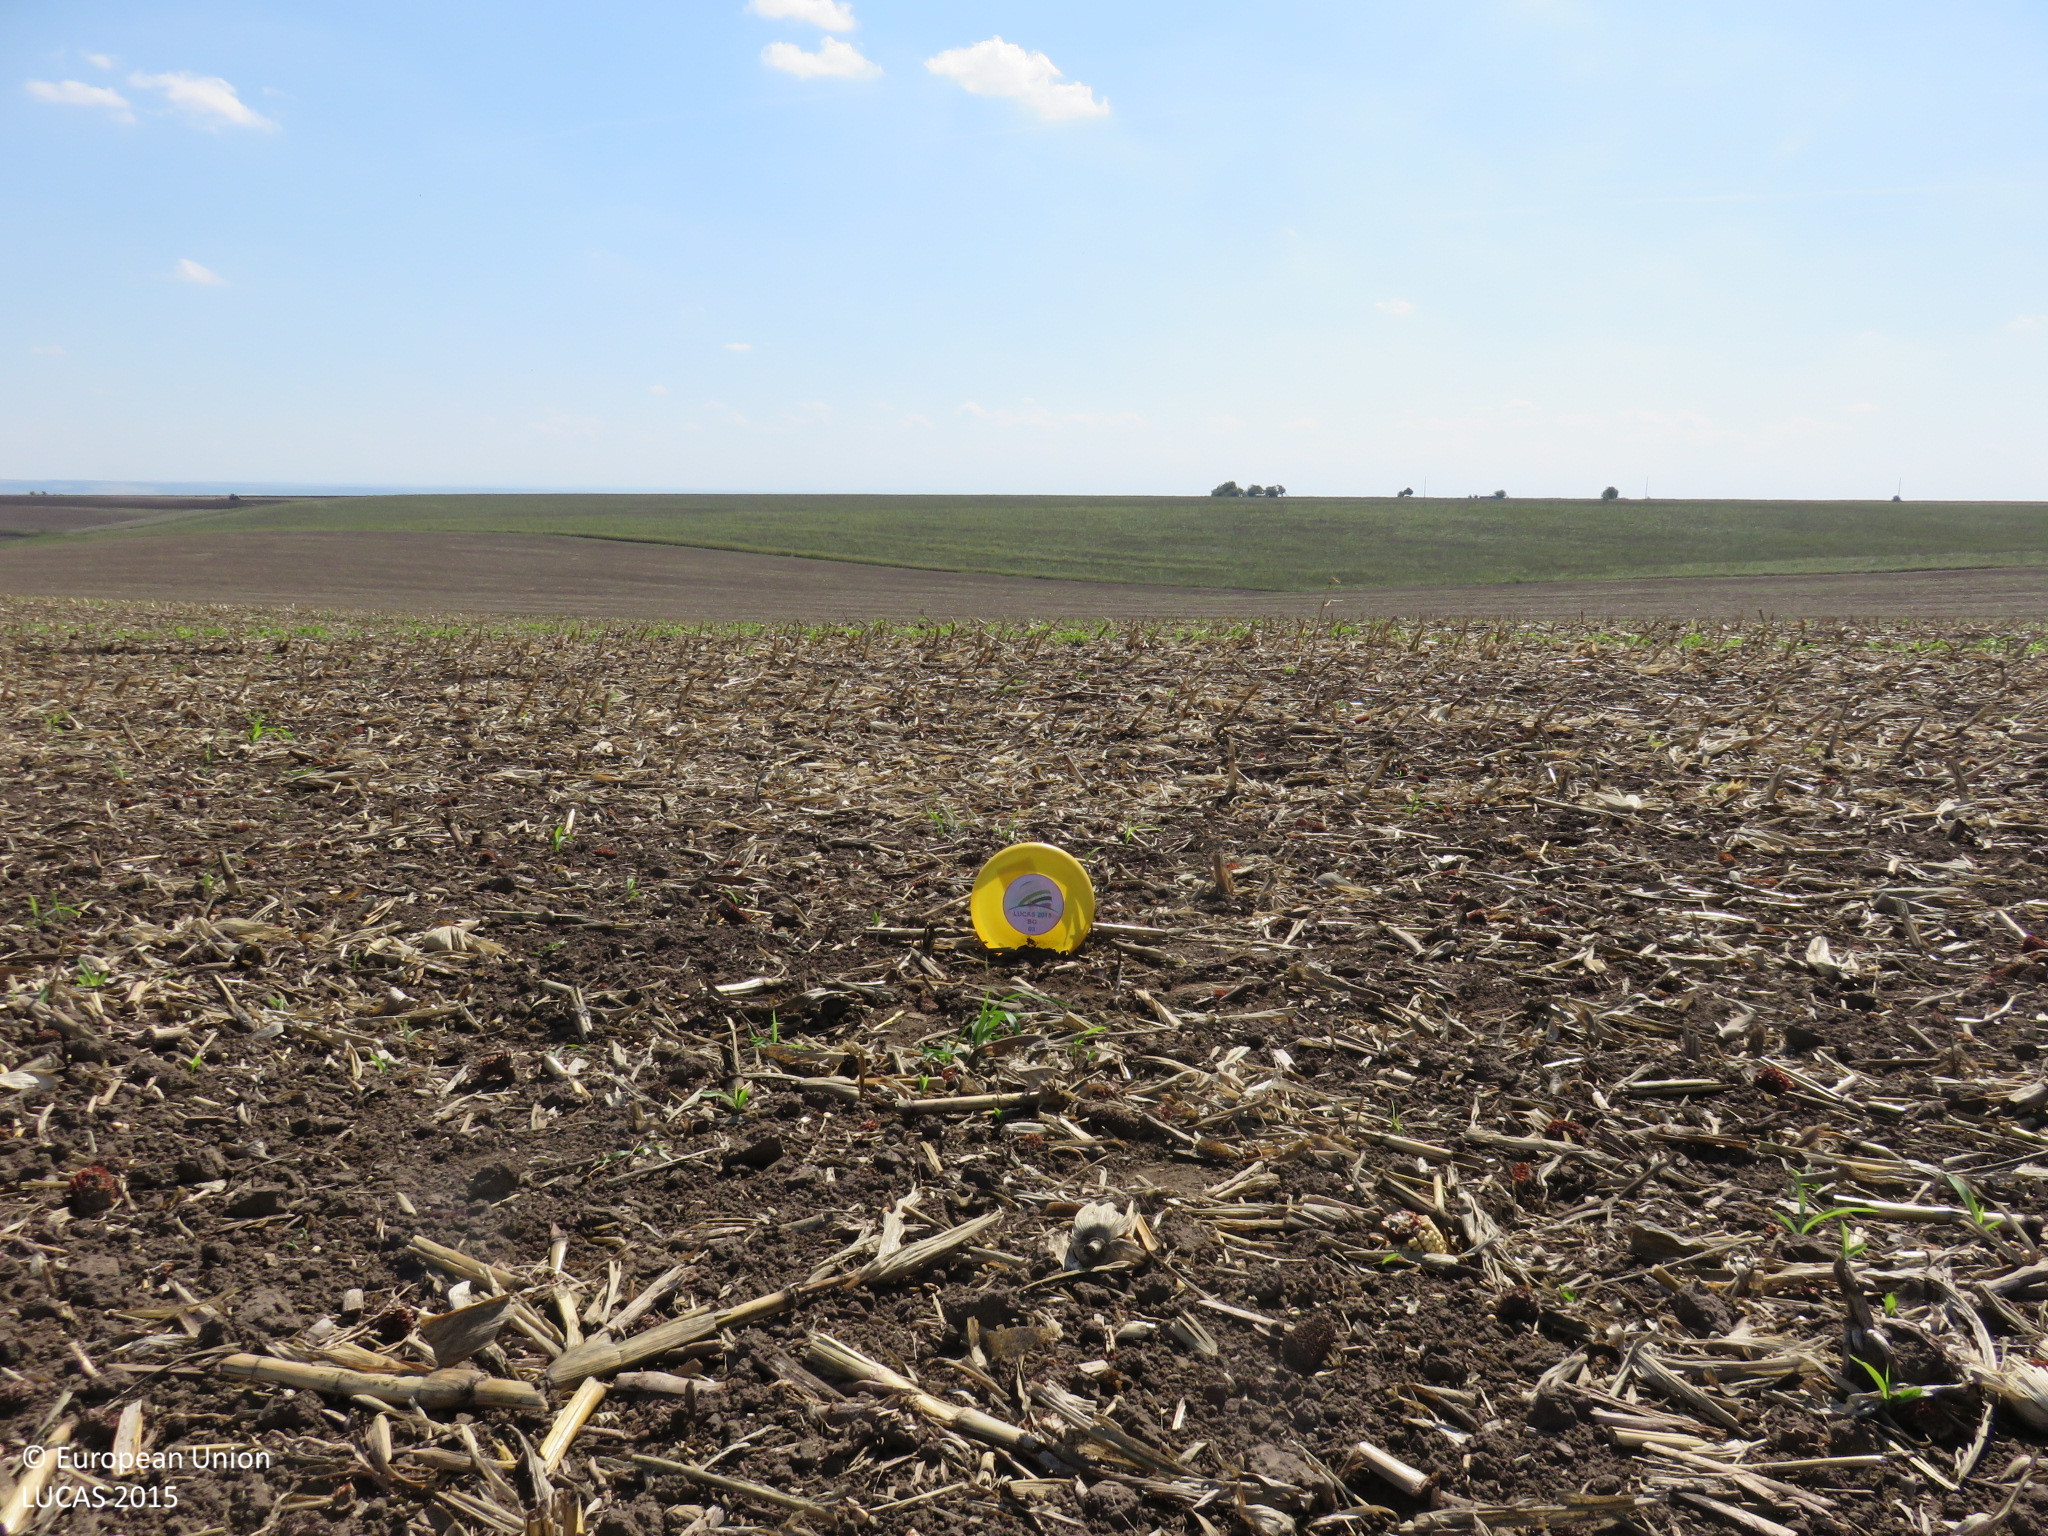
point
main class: Cropland
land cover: Maize
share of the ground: > 75 %
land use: Agriculture (excluding fallow land and kitchen gardens)
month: September
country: BG
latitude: 43.6187
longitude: 24.4992
